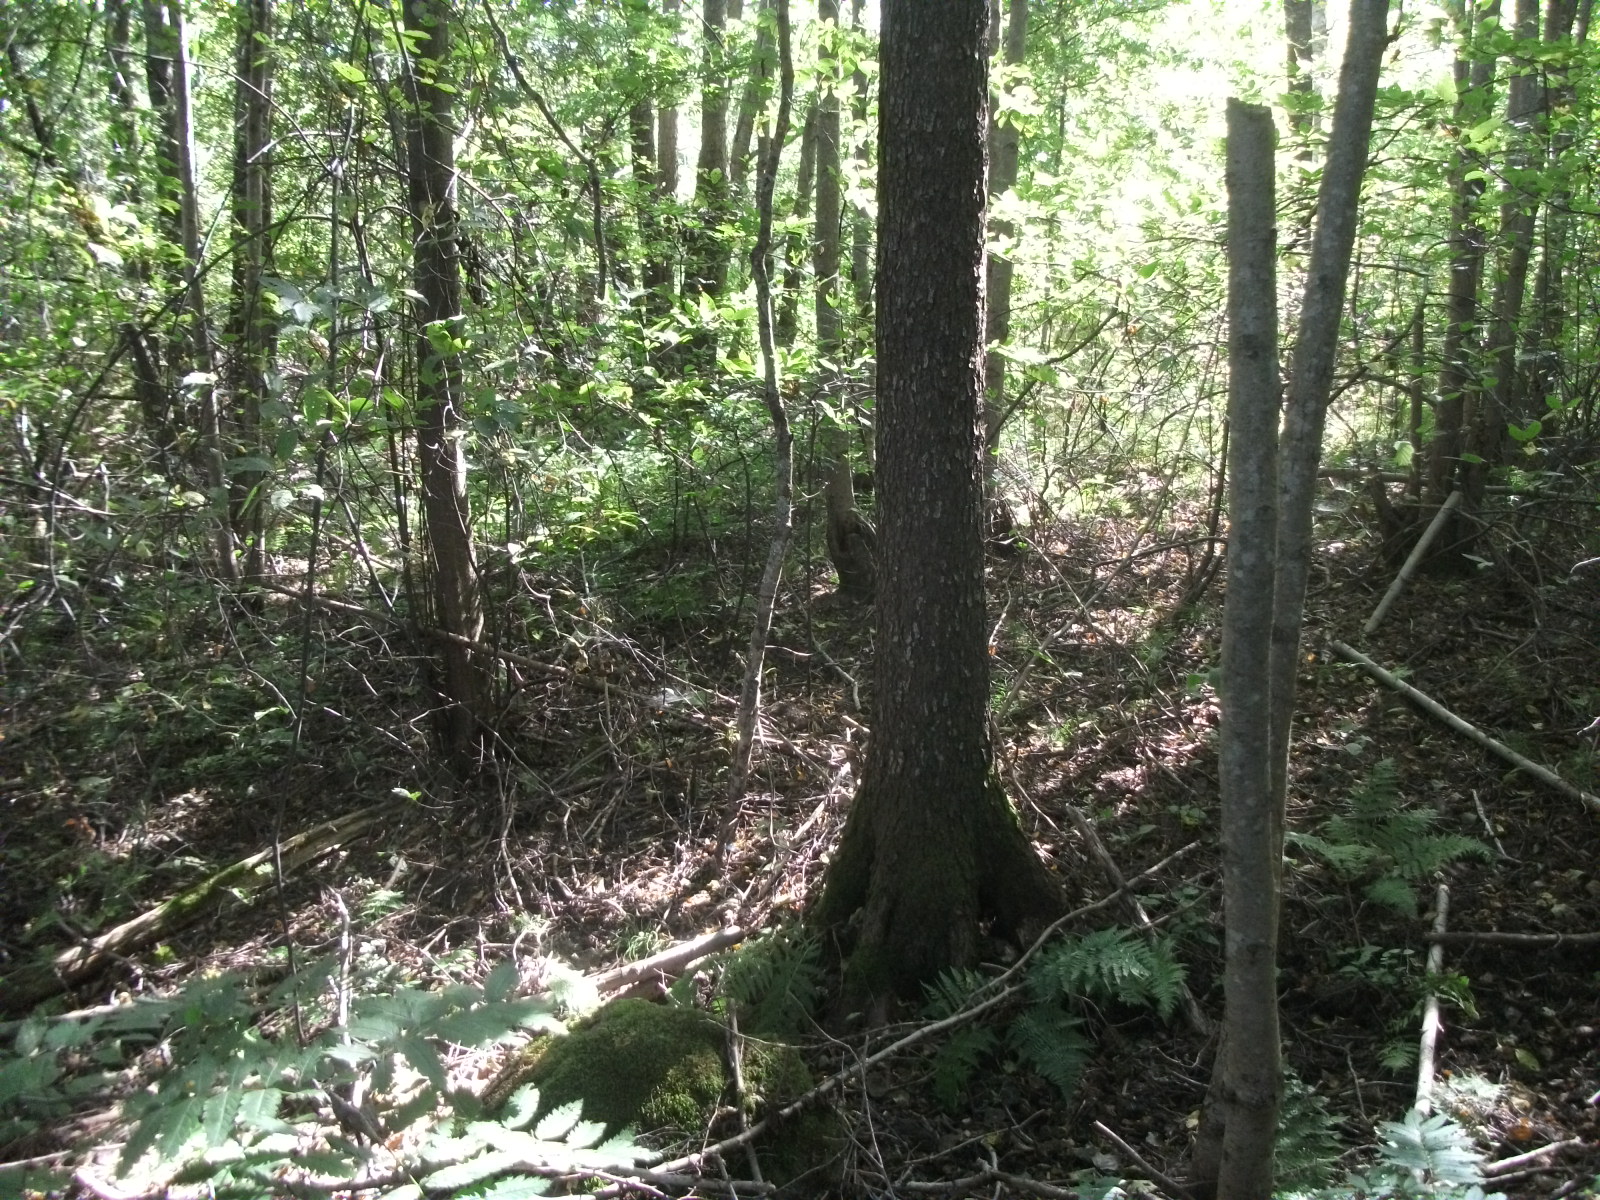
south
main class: Woodland
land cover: Broadleaved woodland
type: non-riverine alder, birch or aspen forest
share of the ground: > 75 %
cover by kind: broadleaved forest trees 95 %, shrubs 5 %
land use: Forestry
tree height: > 5 m
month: August
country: LV
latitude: 56.5237
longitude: 26.0823
